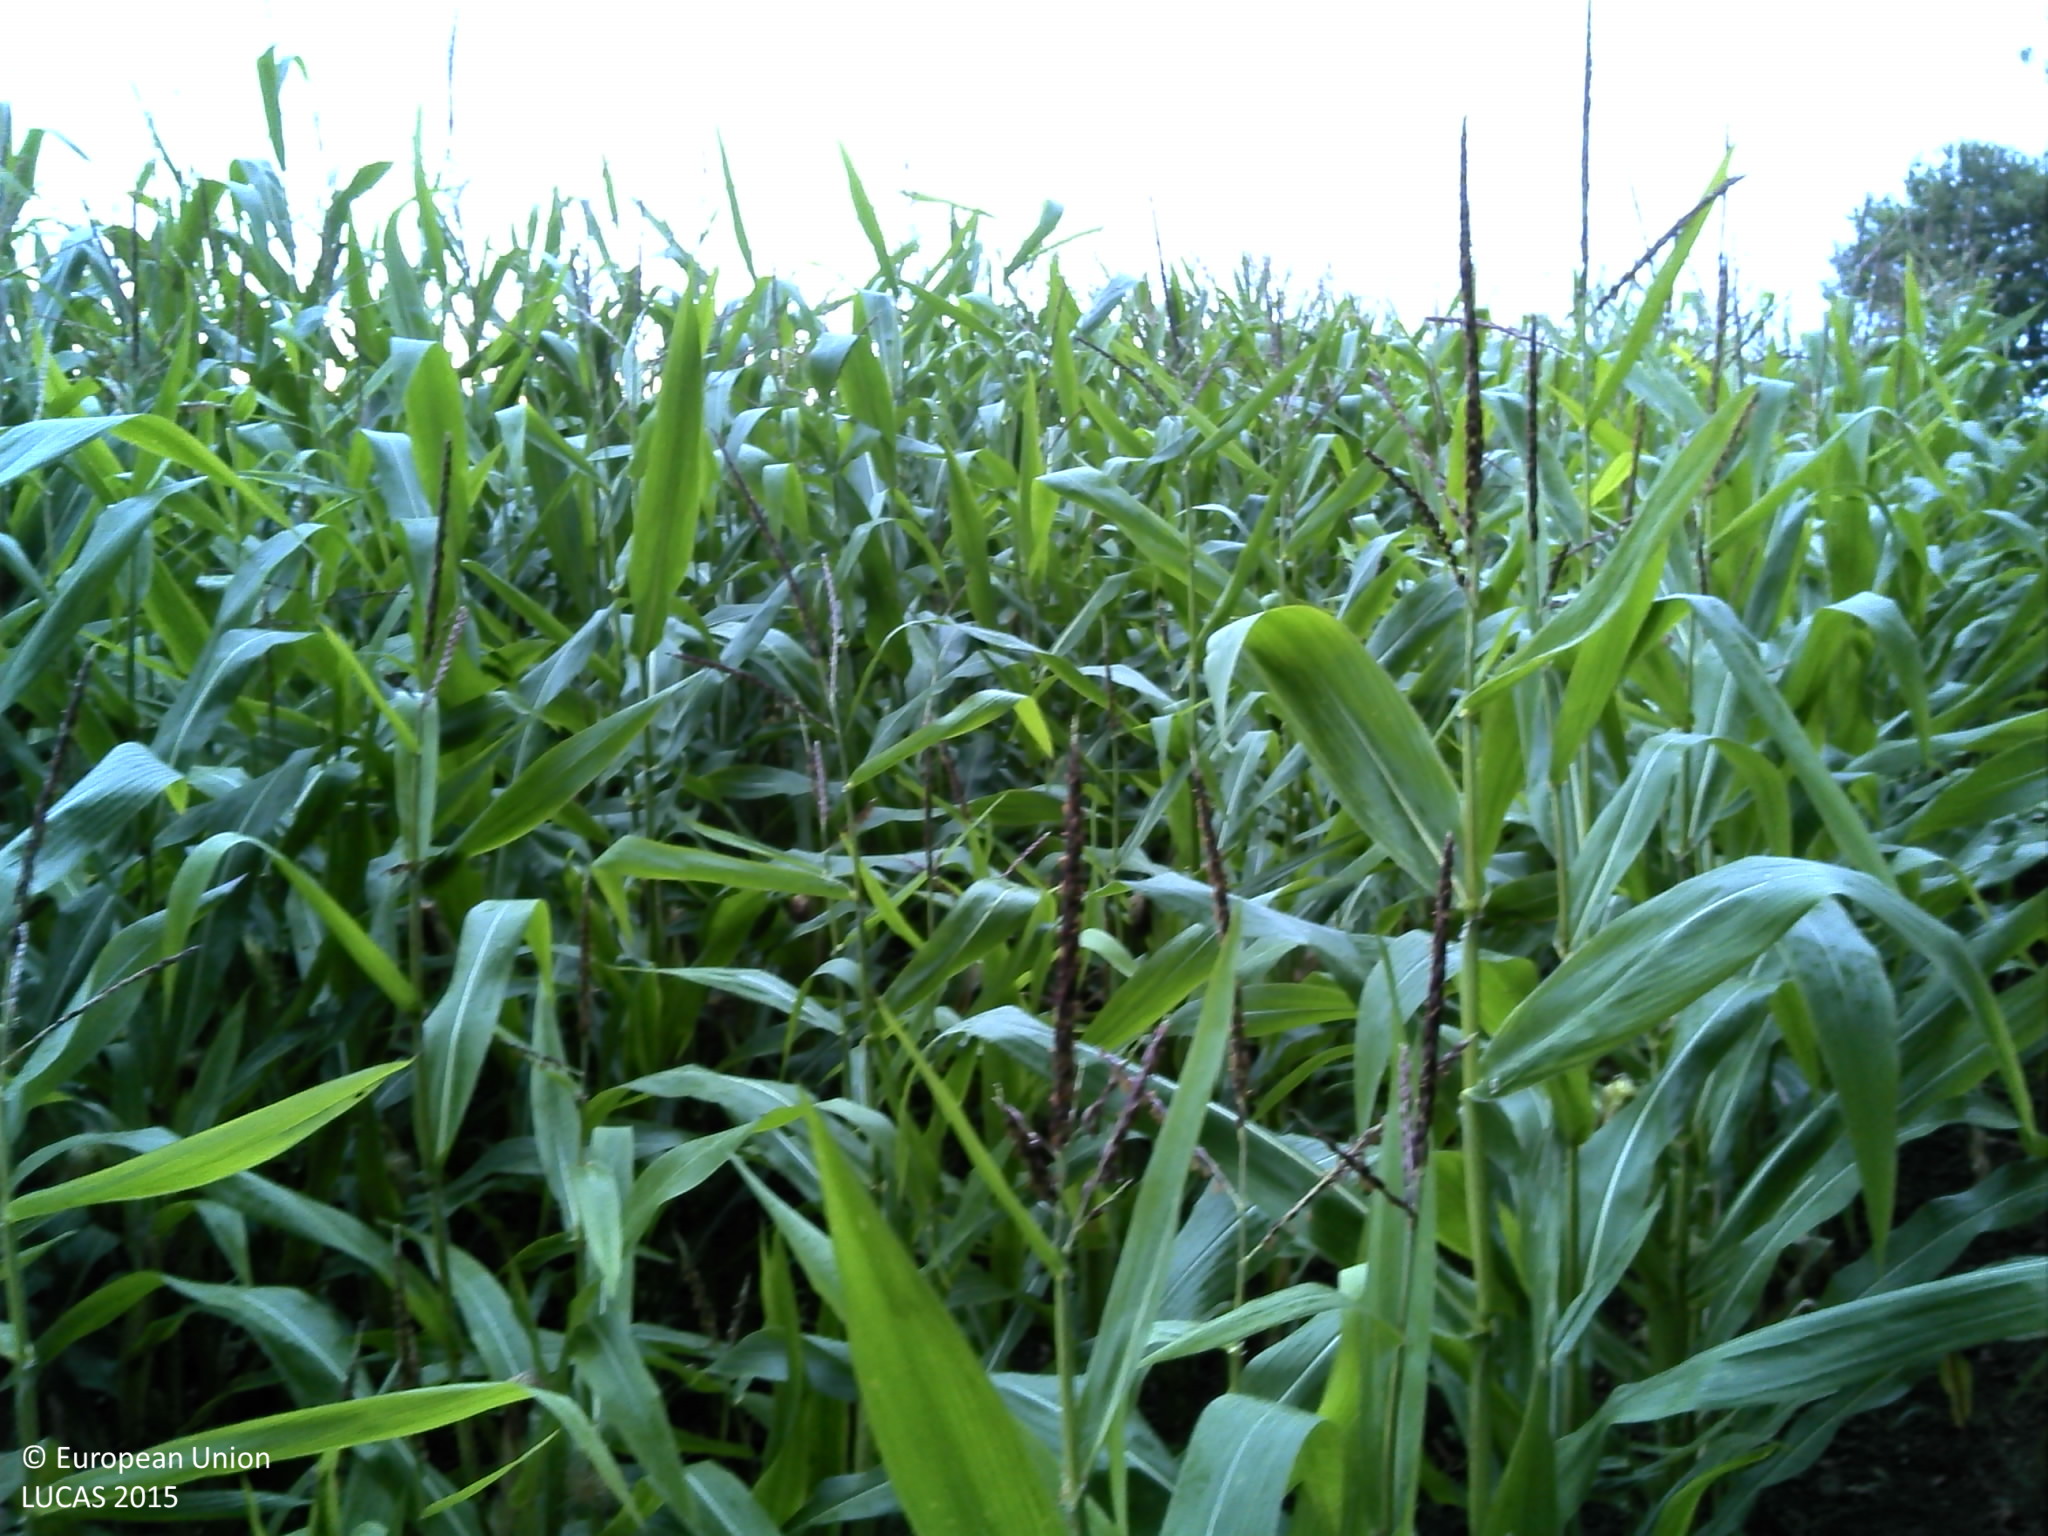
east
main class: Cropland
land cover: Maize
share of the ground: > 75 %
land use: Agriculture (excluding fallow land and kitchen gardens)
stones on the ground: < 10 %
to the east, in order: Maize; Electric lines; Maize; Fences; Lines of trees; Common wheat; Broadleaved woodland; Maize
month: September
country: FR
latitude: 48.5430
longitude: -3.7510
